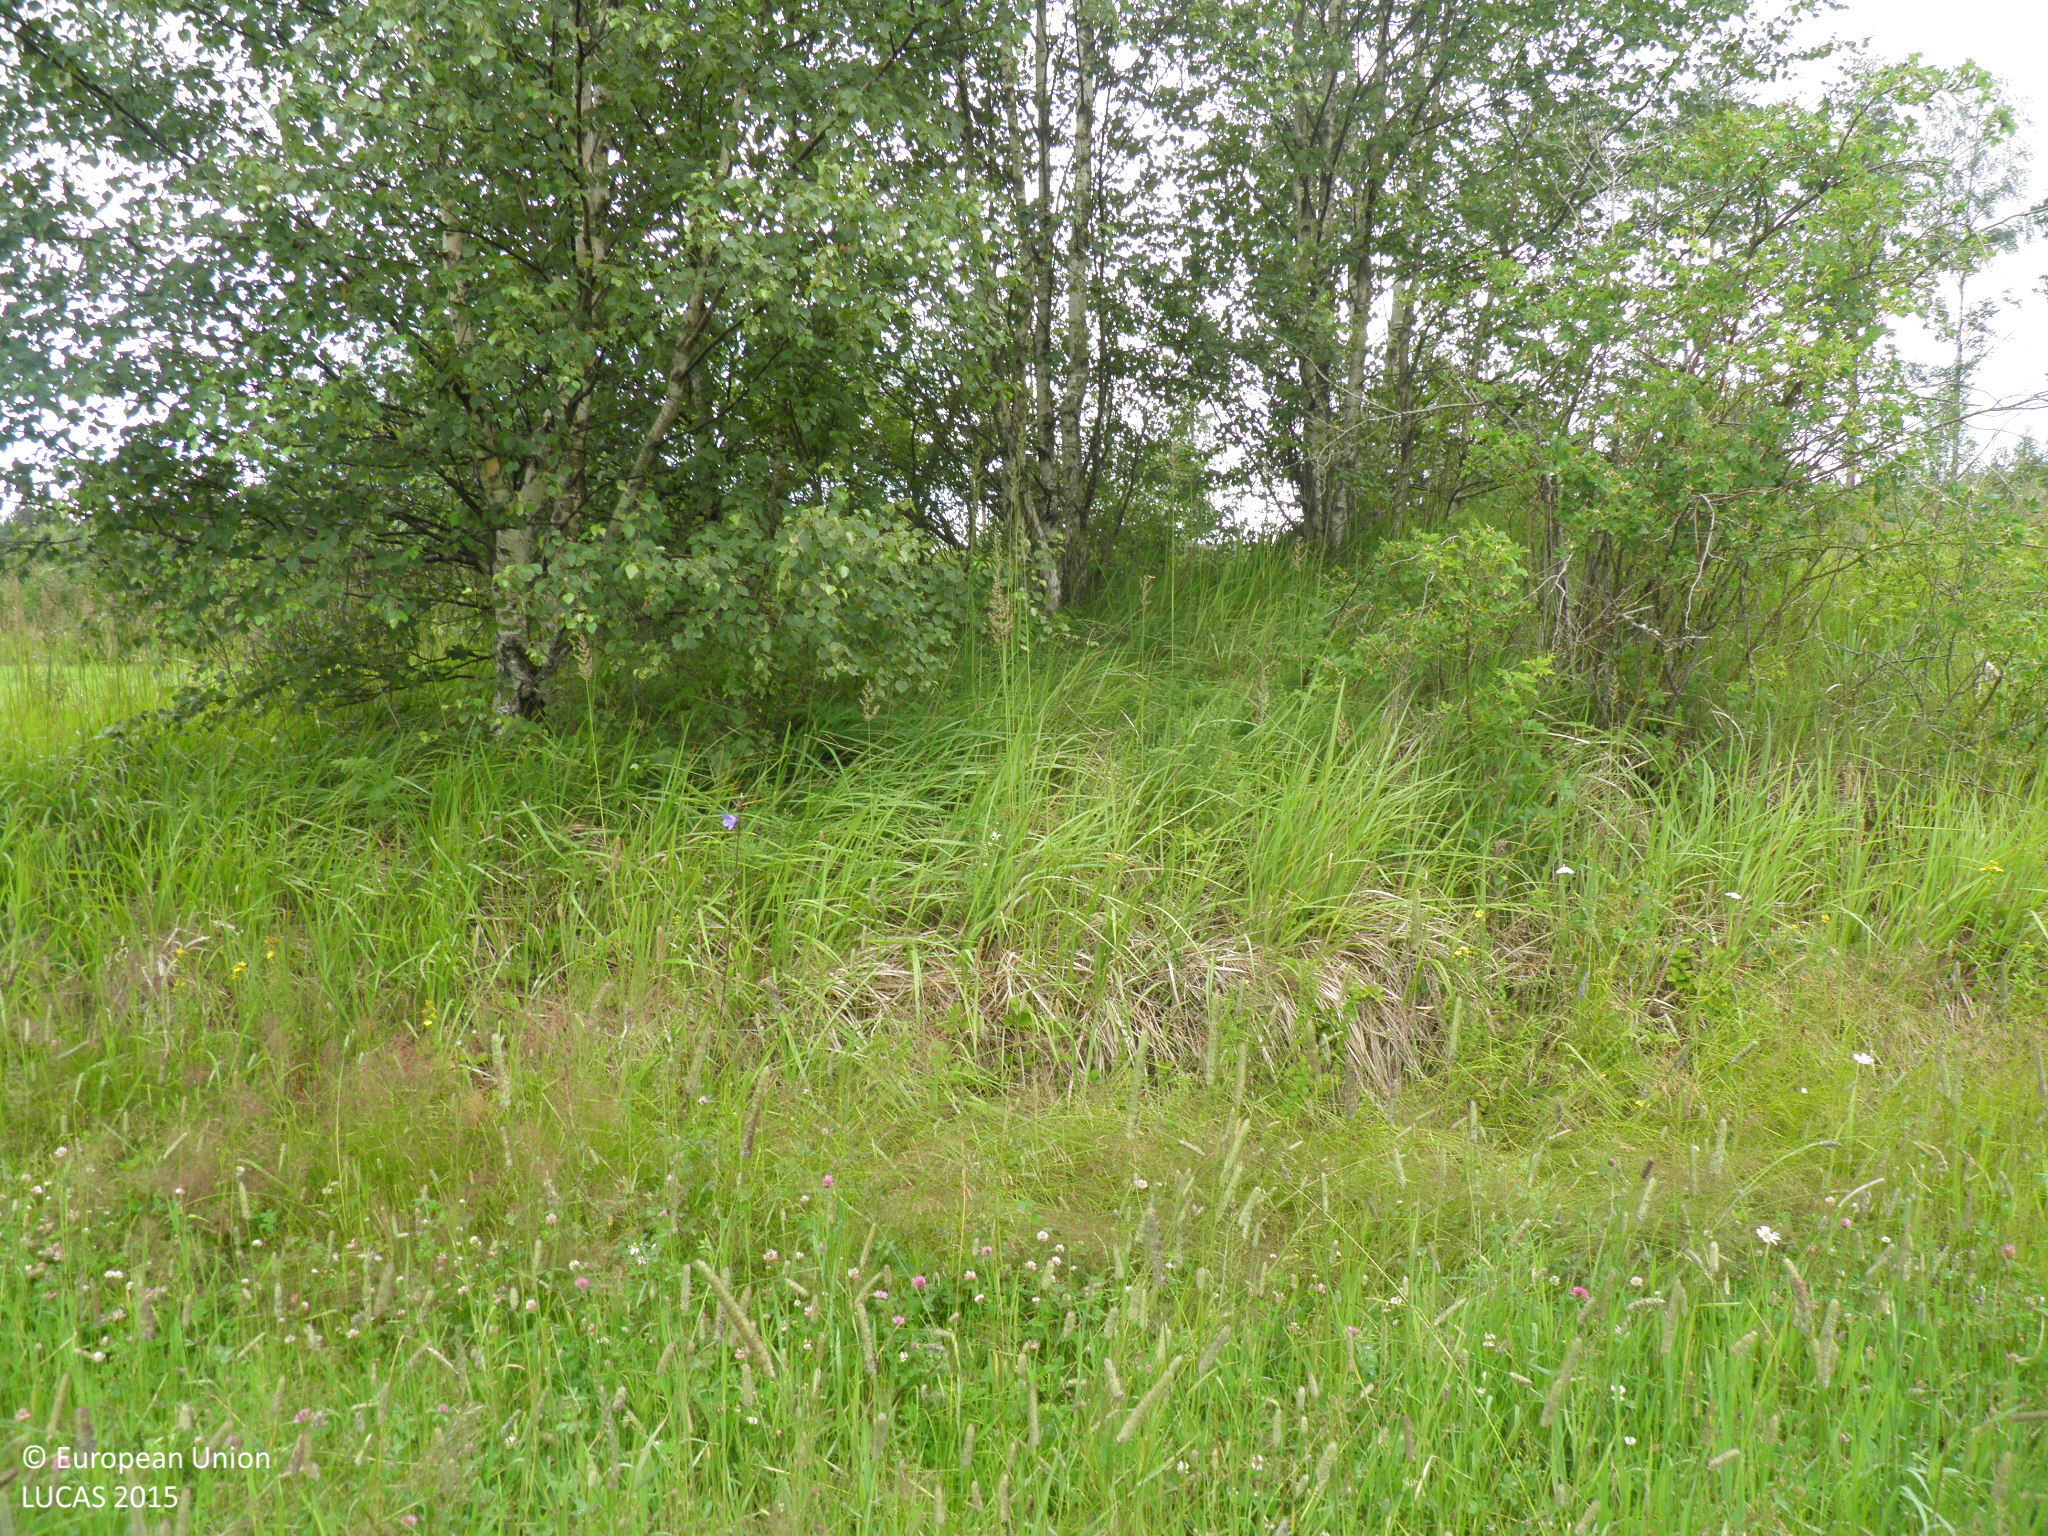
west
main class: Cropland
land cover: Barley
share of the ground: > 75 %
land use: Agriculture (excluding fallow land and kitchen gardens)
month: July
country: FI
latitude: 60.0854
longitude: 22.4215
